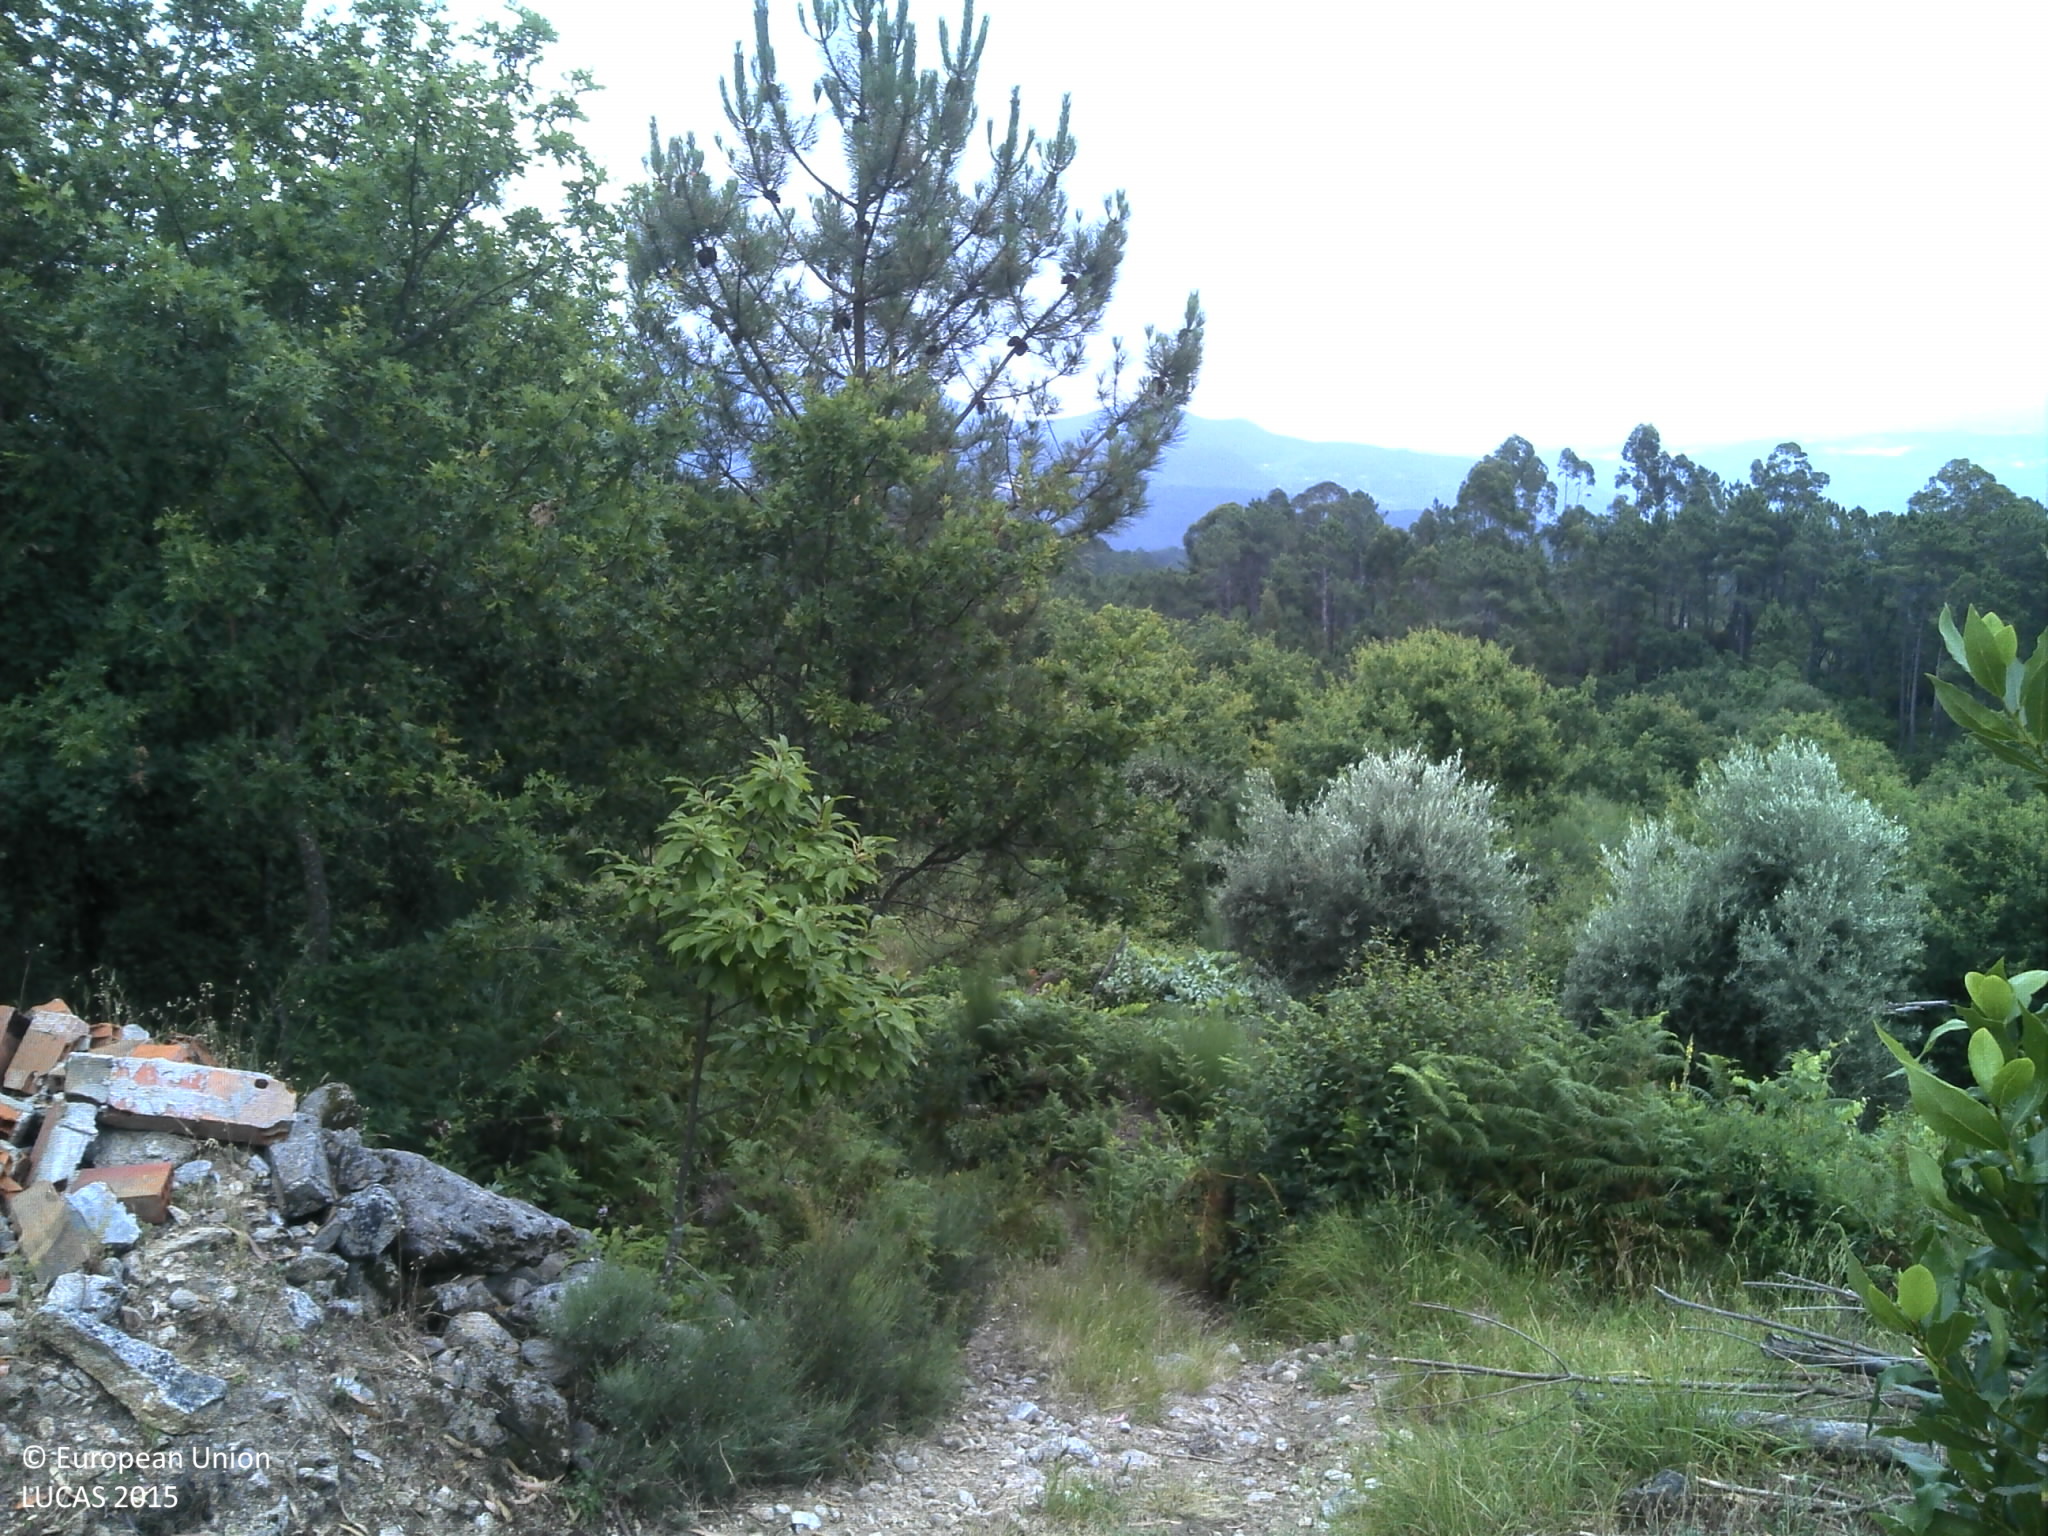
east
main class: Grassland
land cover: Grassland without tree/shrub cover
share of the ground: 50 - 75 %
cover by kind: herbaceous plants 75 %, unconsolidated bare surface 25 %
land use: Agriculture (excluding fallow land and kitchen gardens)
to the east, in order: Grassland without tree/shrub cover; Dry stone walls; Grass margins; Oranges; Tracks; Rocks and stones; Broadleaved woodland; Shrubland with sparse tree cover; Broadleaved woodland; Arable land (only in case pi); Tracks; Broadleaved woodland
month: June
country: PT
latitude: 40.7844
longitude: -8.3033
